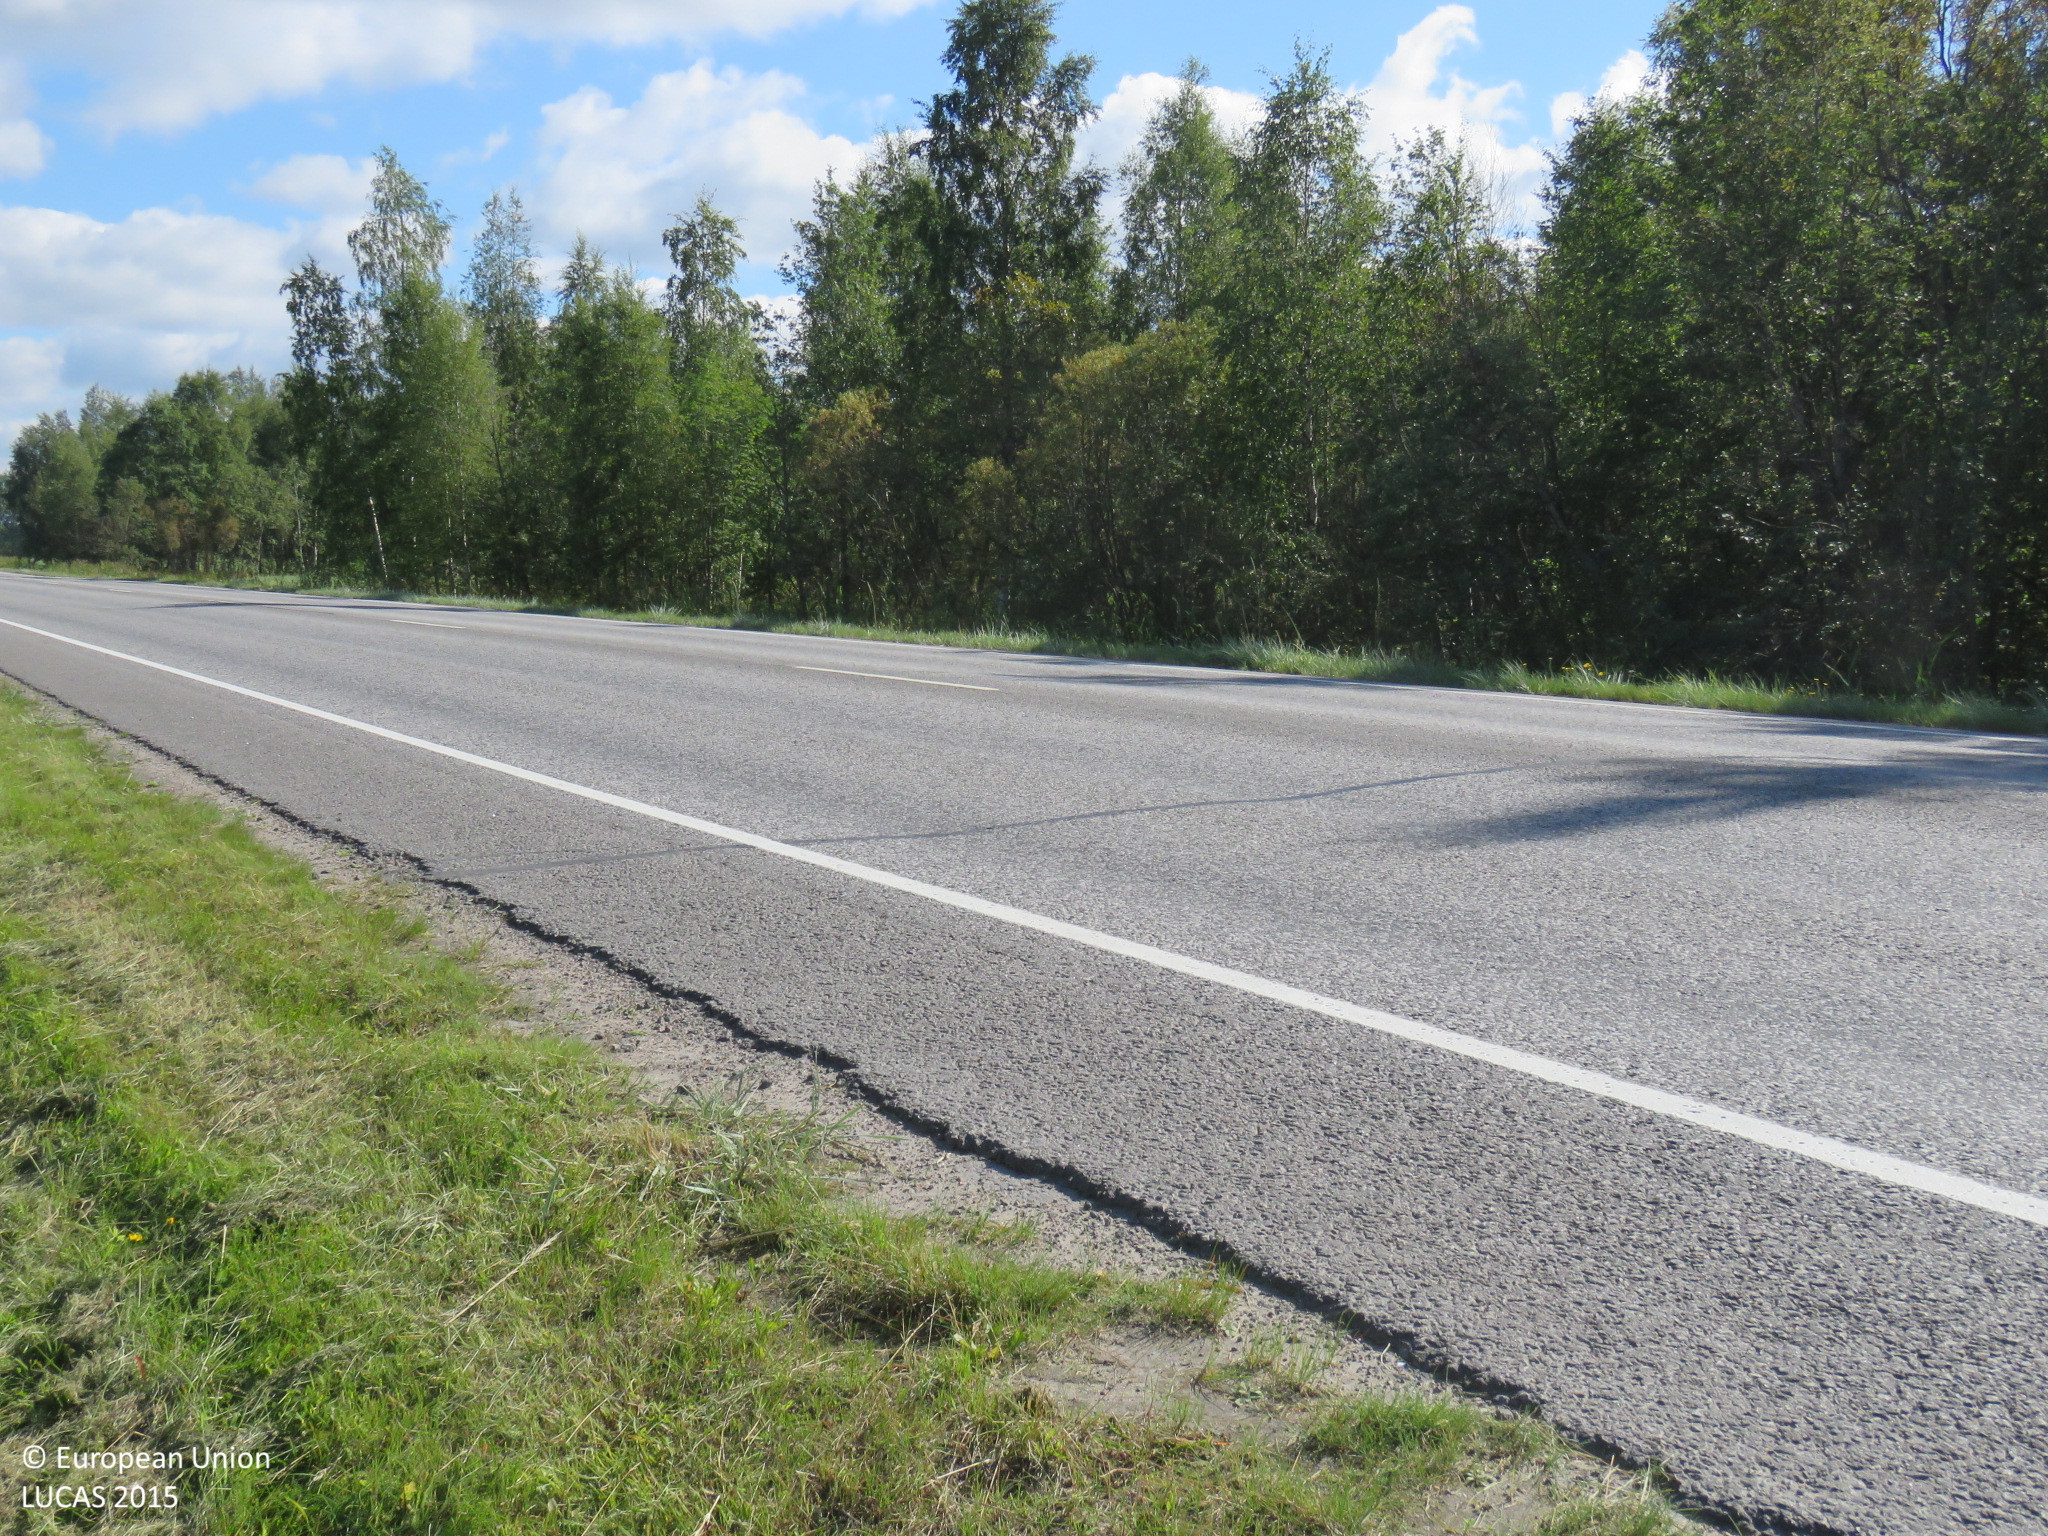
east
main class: Grassland
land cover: Grassland without tree/shrub cover
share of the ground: > 75 %
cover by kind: herbaceous plants 95 %, unconsolidated bare surface 5 %
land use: Road transport
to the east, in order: Grassland without tree/shrub cover; Paved roads, cycling and walking lanes; Grassland without tree/shrub cover; Ditches and canals; Broadleaved woodland; Ditches and canals; Oats; Ditches and canals; Grassland without tree/shrub cover; Oats; Grass margins; Ditches and canals; Oats
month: August
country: FI
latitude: 64.9457
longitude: 25.4698
